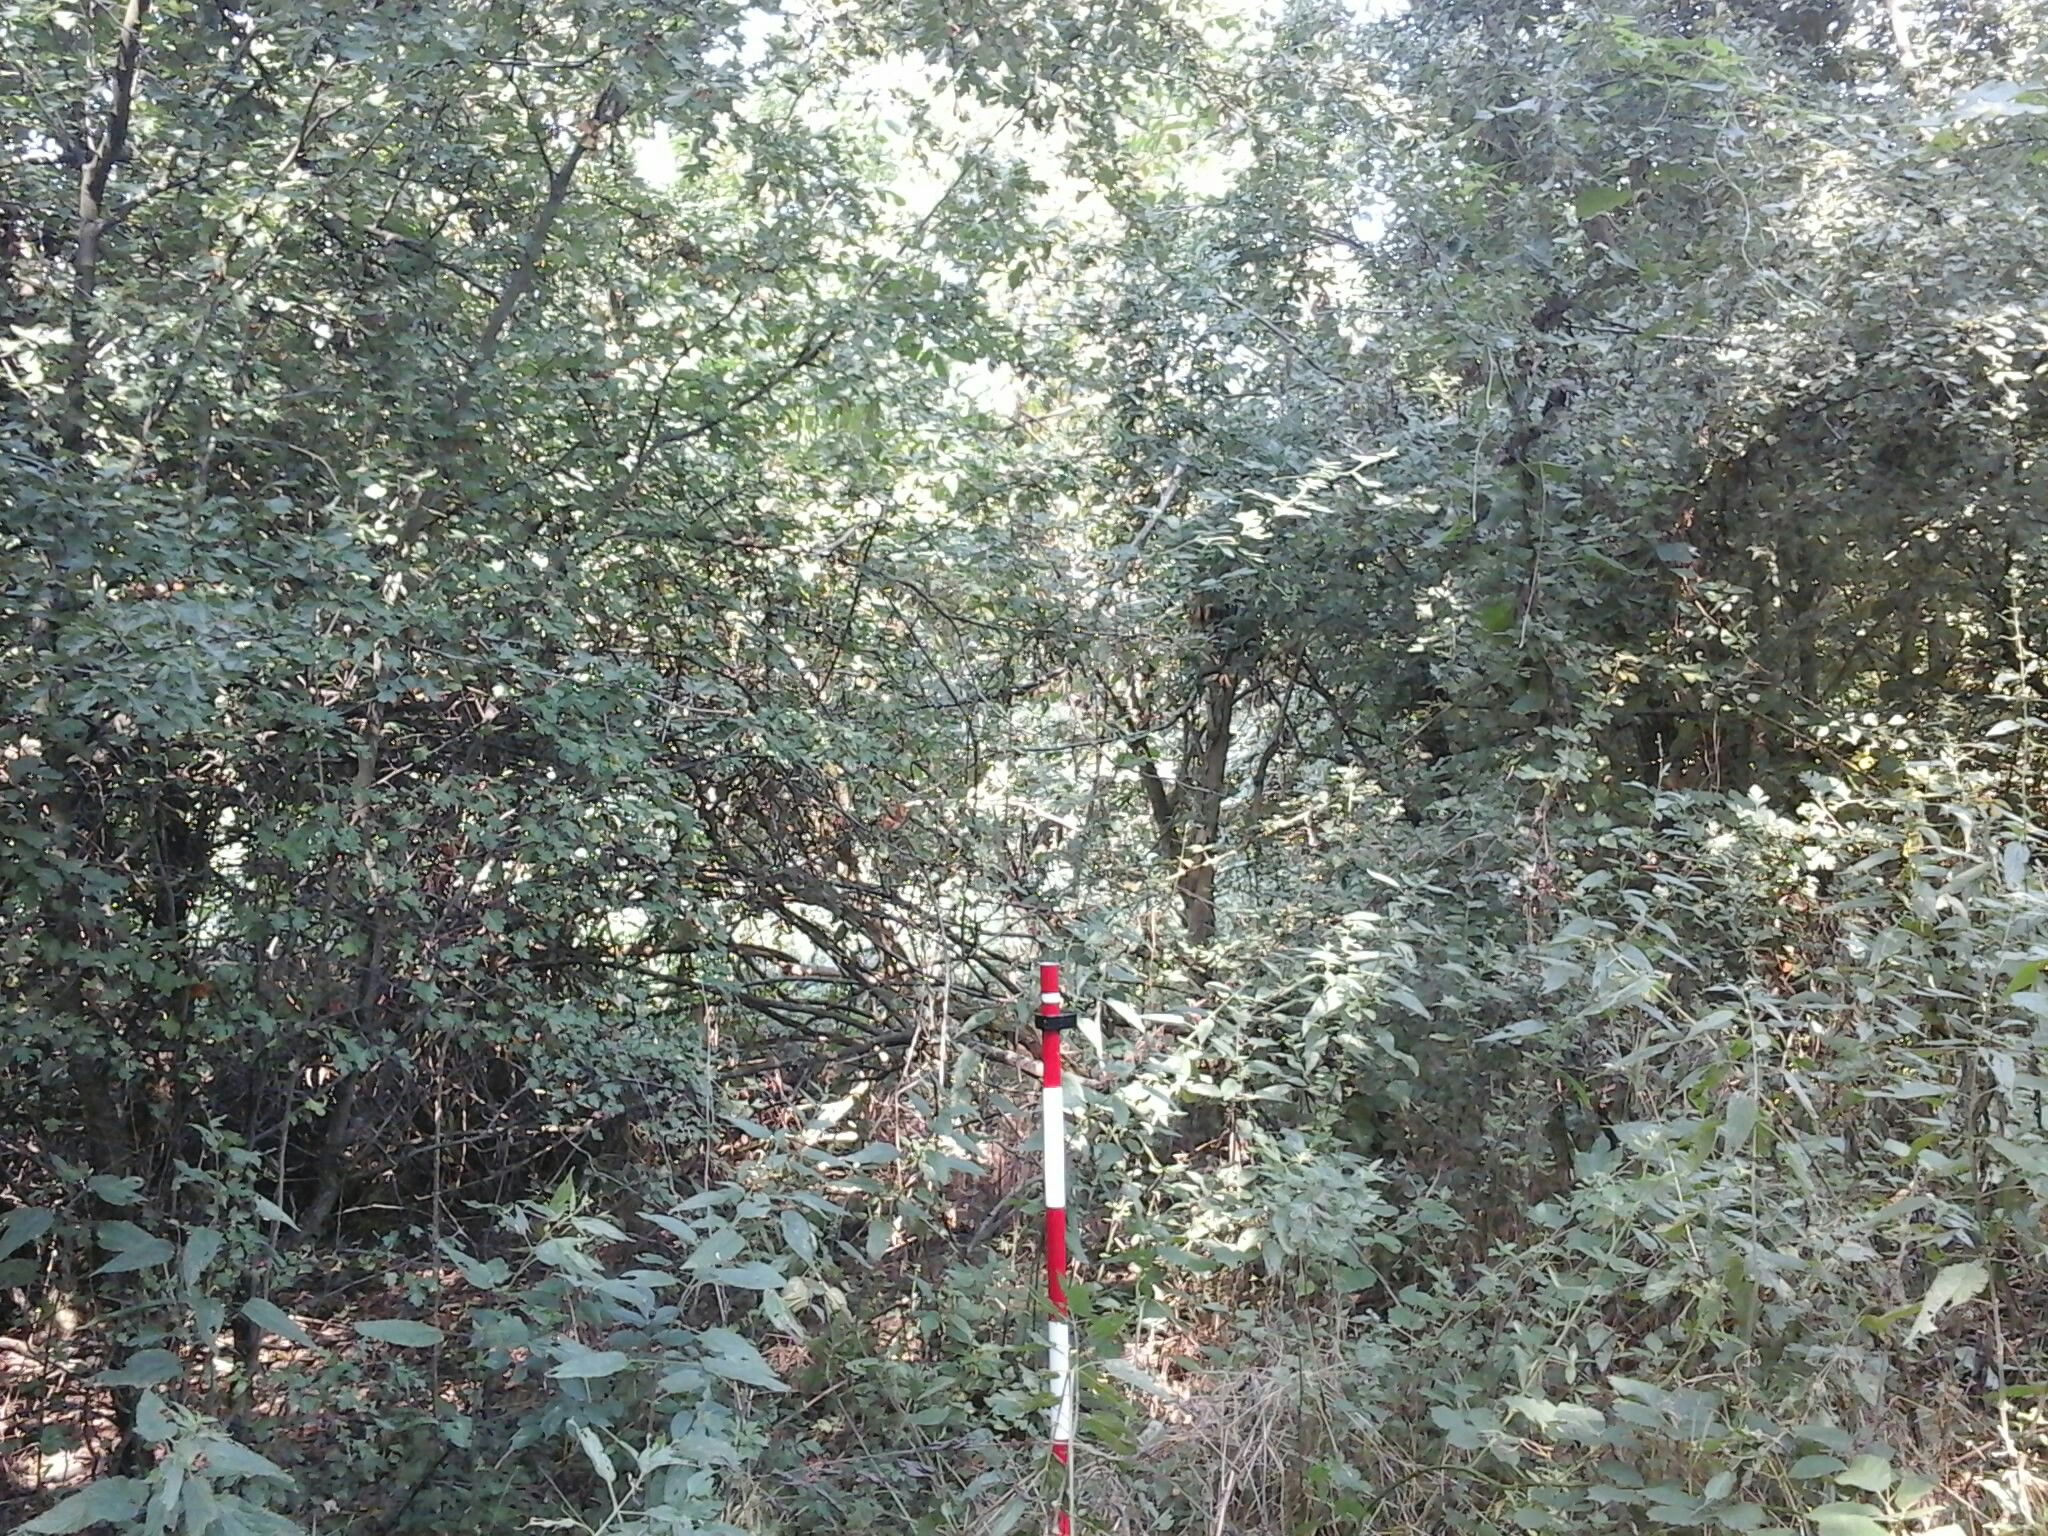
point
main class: Woodland
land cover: Broadleaved woodland
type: mesophytic deciduous forest
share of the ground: > 75 %
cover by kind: broadleaved forest trees 95 %, herbaceous plants 5 %
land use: Forestry
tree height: > 5 m
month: August
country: HU
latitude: 47.3978
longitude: 17.8933
